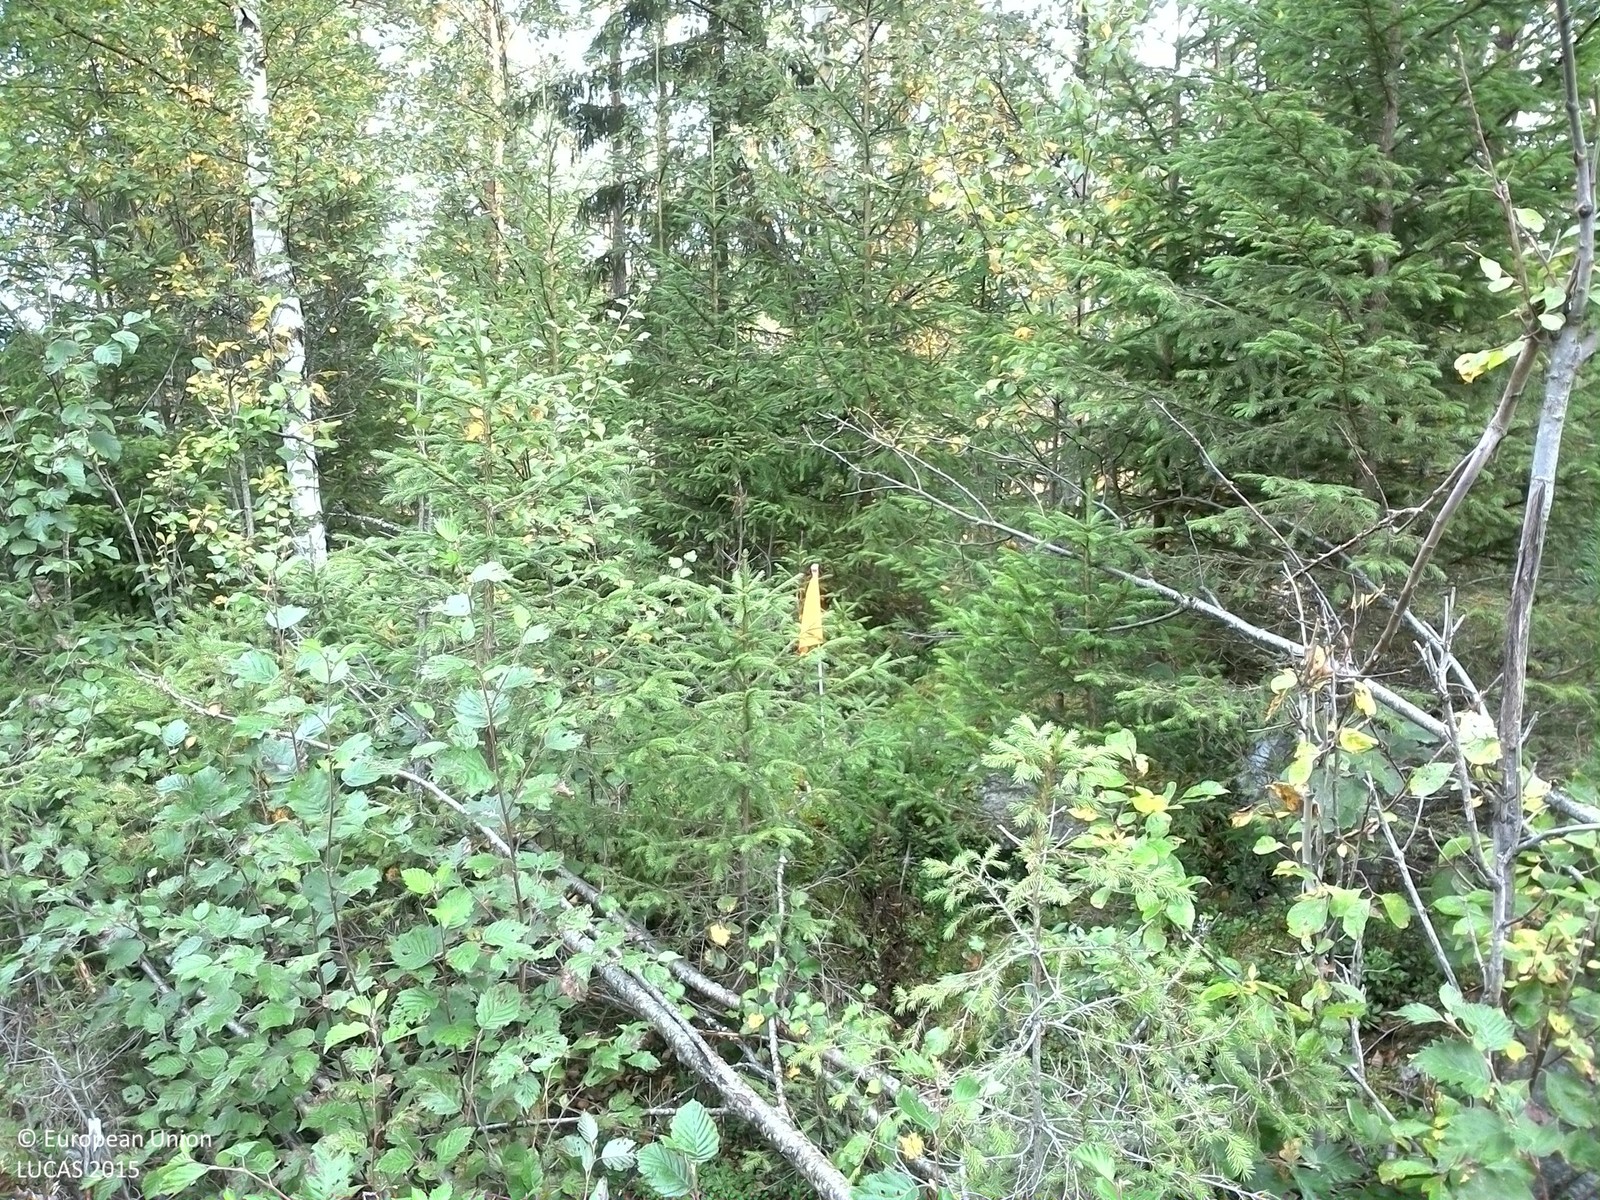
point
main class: Woodland
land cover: Other mixed woodland
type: boreal forest
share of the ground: 25 - 50 %
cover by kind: shrubs 30 %, coniferous forest trees 20 %, broadleaved forest trees 20 %, lichens and mosses 15 %, herbaceous plants 10 %, consolidated bare surface 5 %
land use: Forestry
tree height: > 5 m
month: September
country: SE
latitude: 61.6316
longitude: 15.3605
